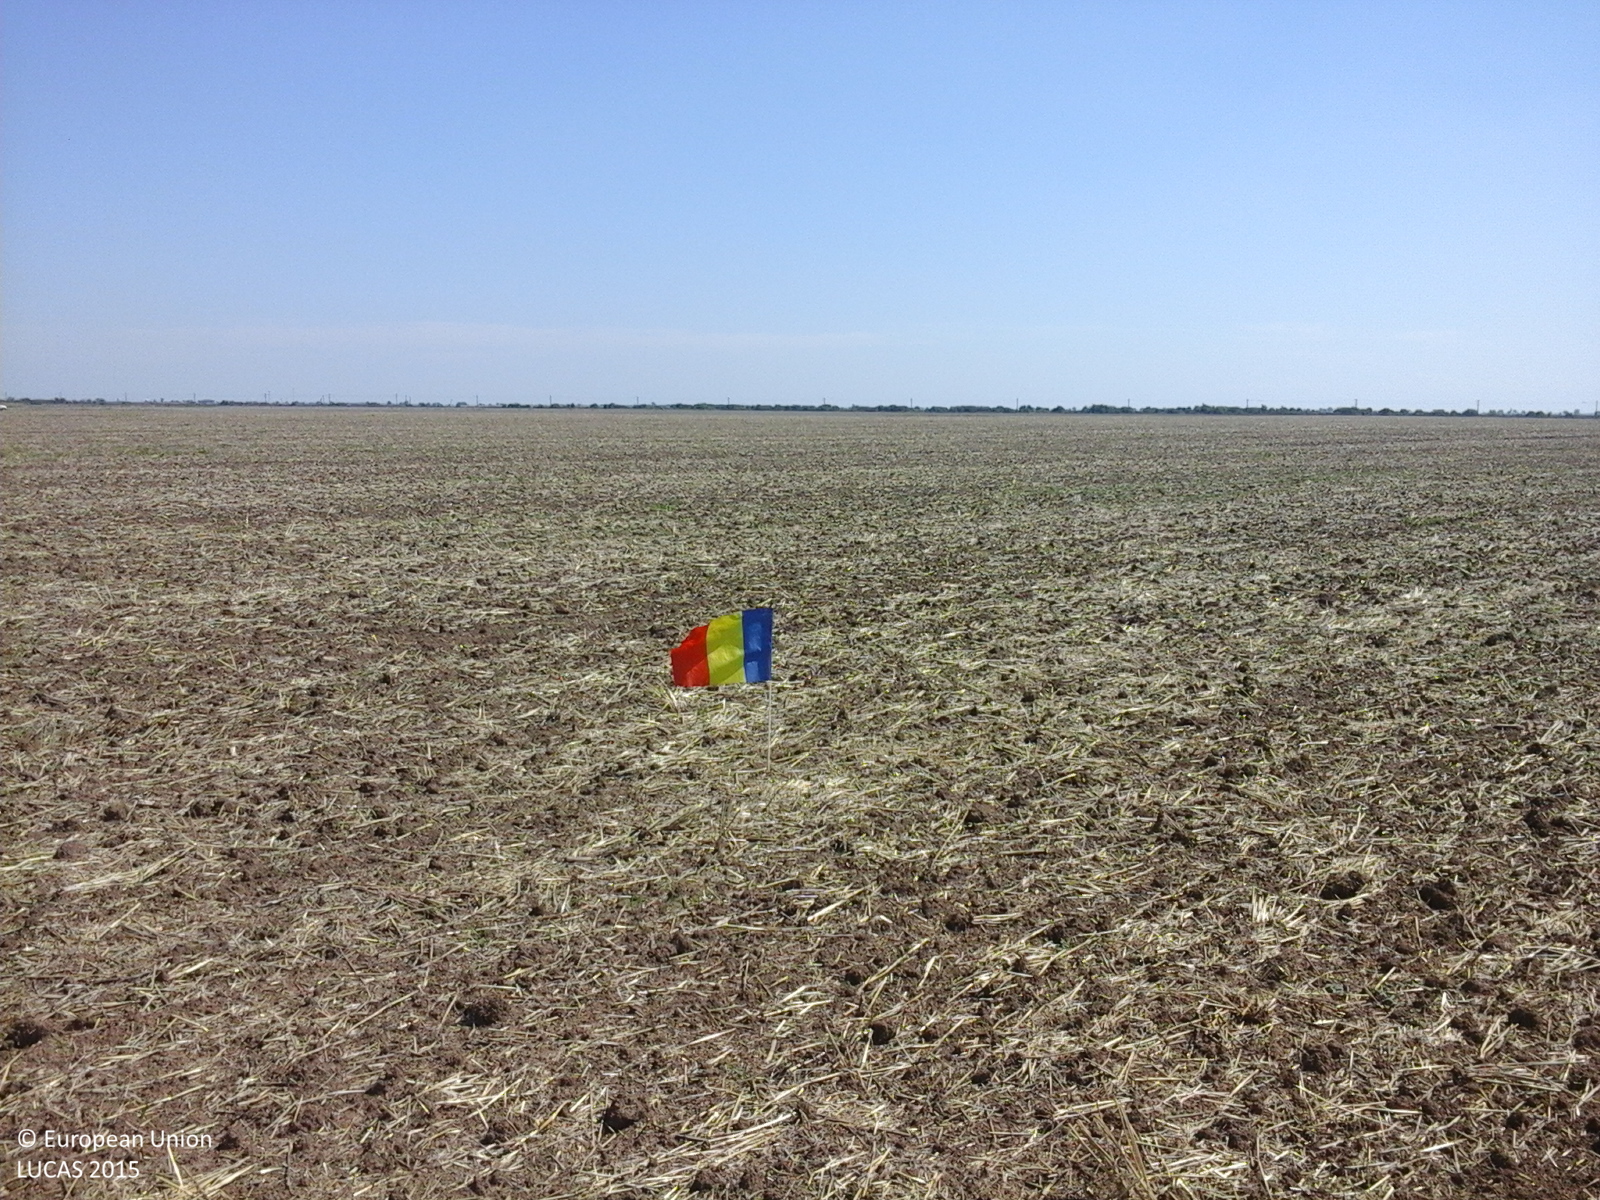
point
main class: Cropland
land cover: Common wheat
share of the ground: 25 - 50 %
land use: Agriculture (excluding fallow land and kitchen gardens)
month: August
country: RO
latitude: 45.8933
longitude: 21.1525
